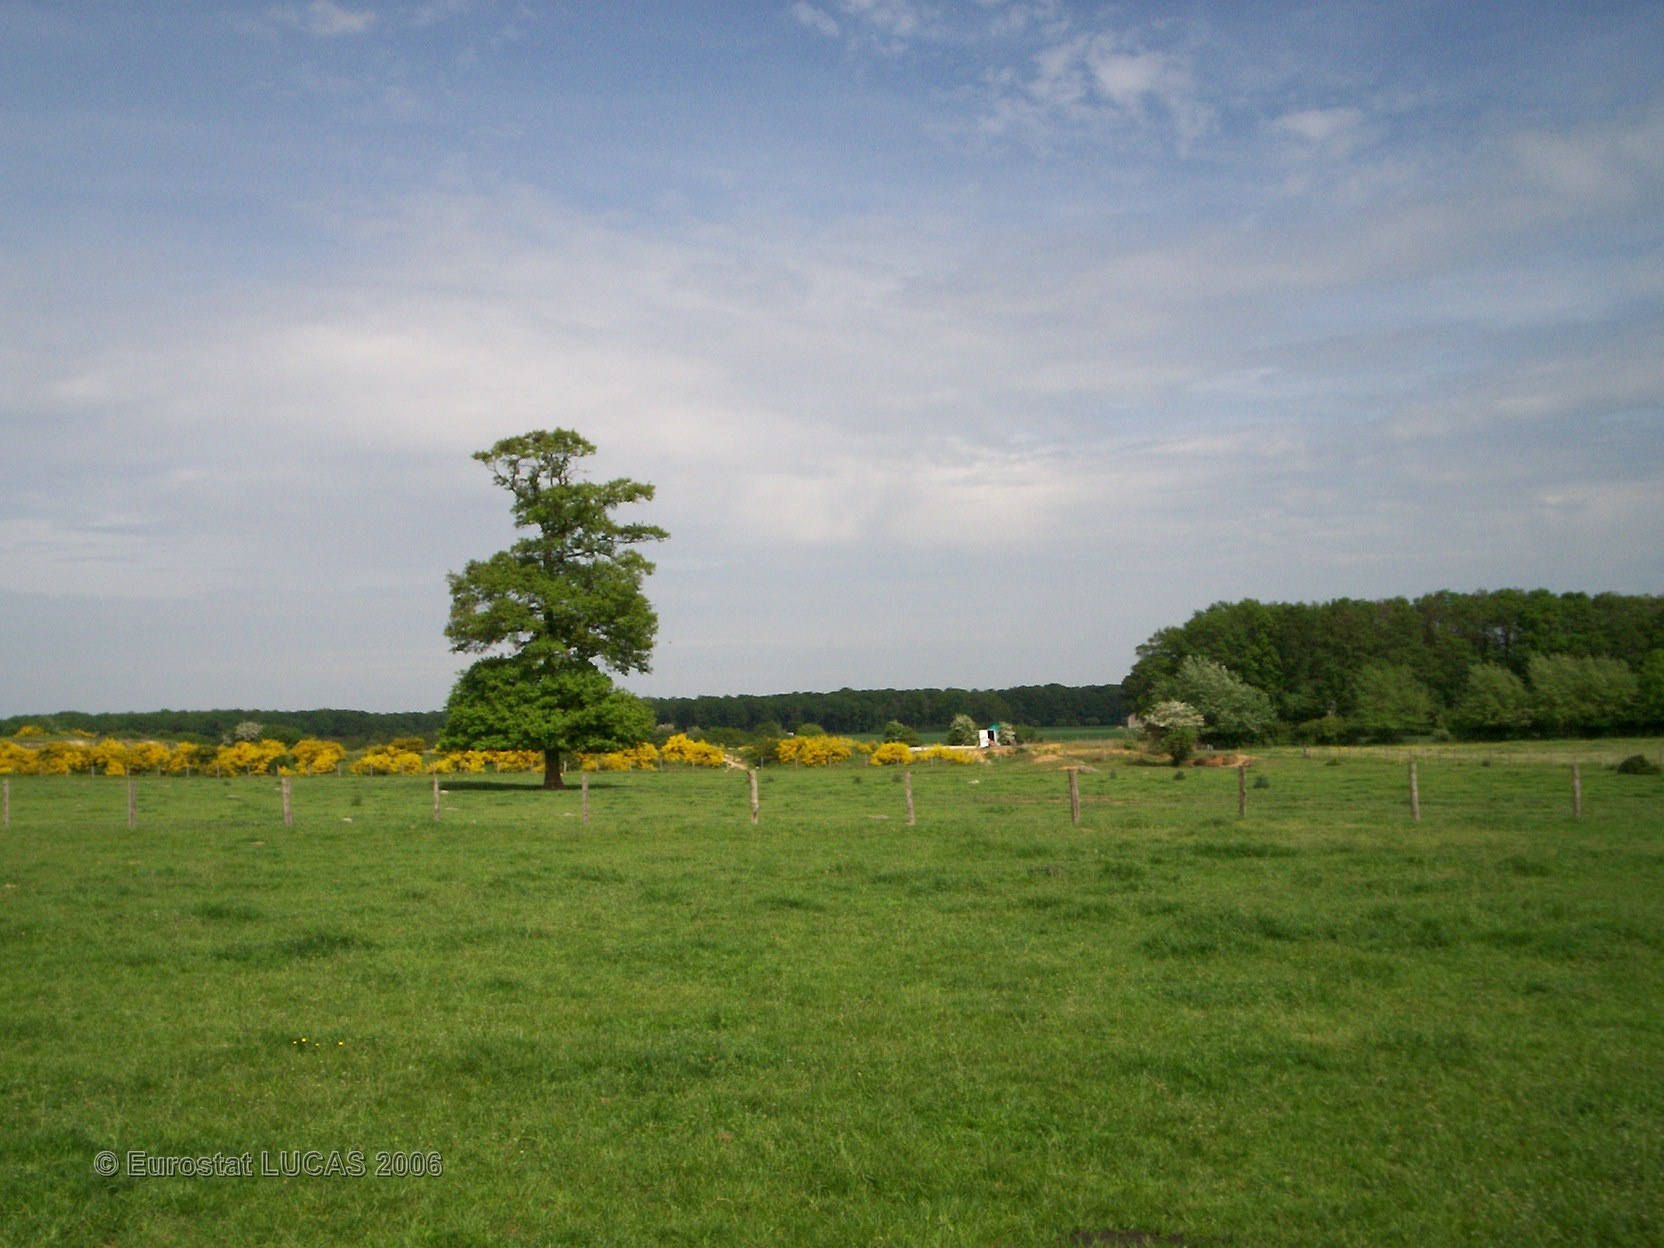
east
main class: Grassland
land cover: Grassland without tree/shrub cover
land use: Agriculture (excluding fallow land and kitchen gardens)
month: May
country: FR
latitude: 48.6622
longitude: 2.8902
